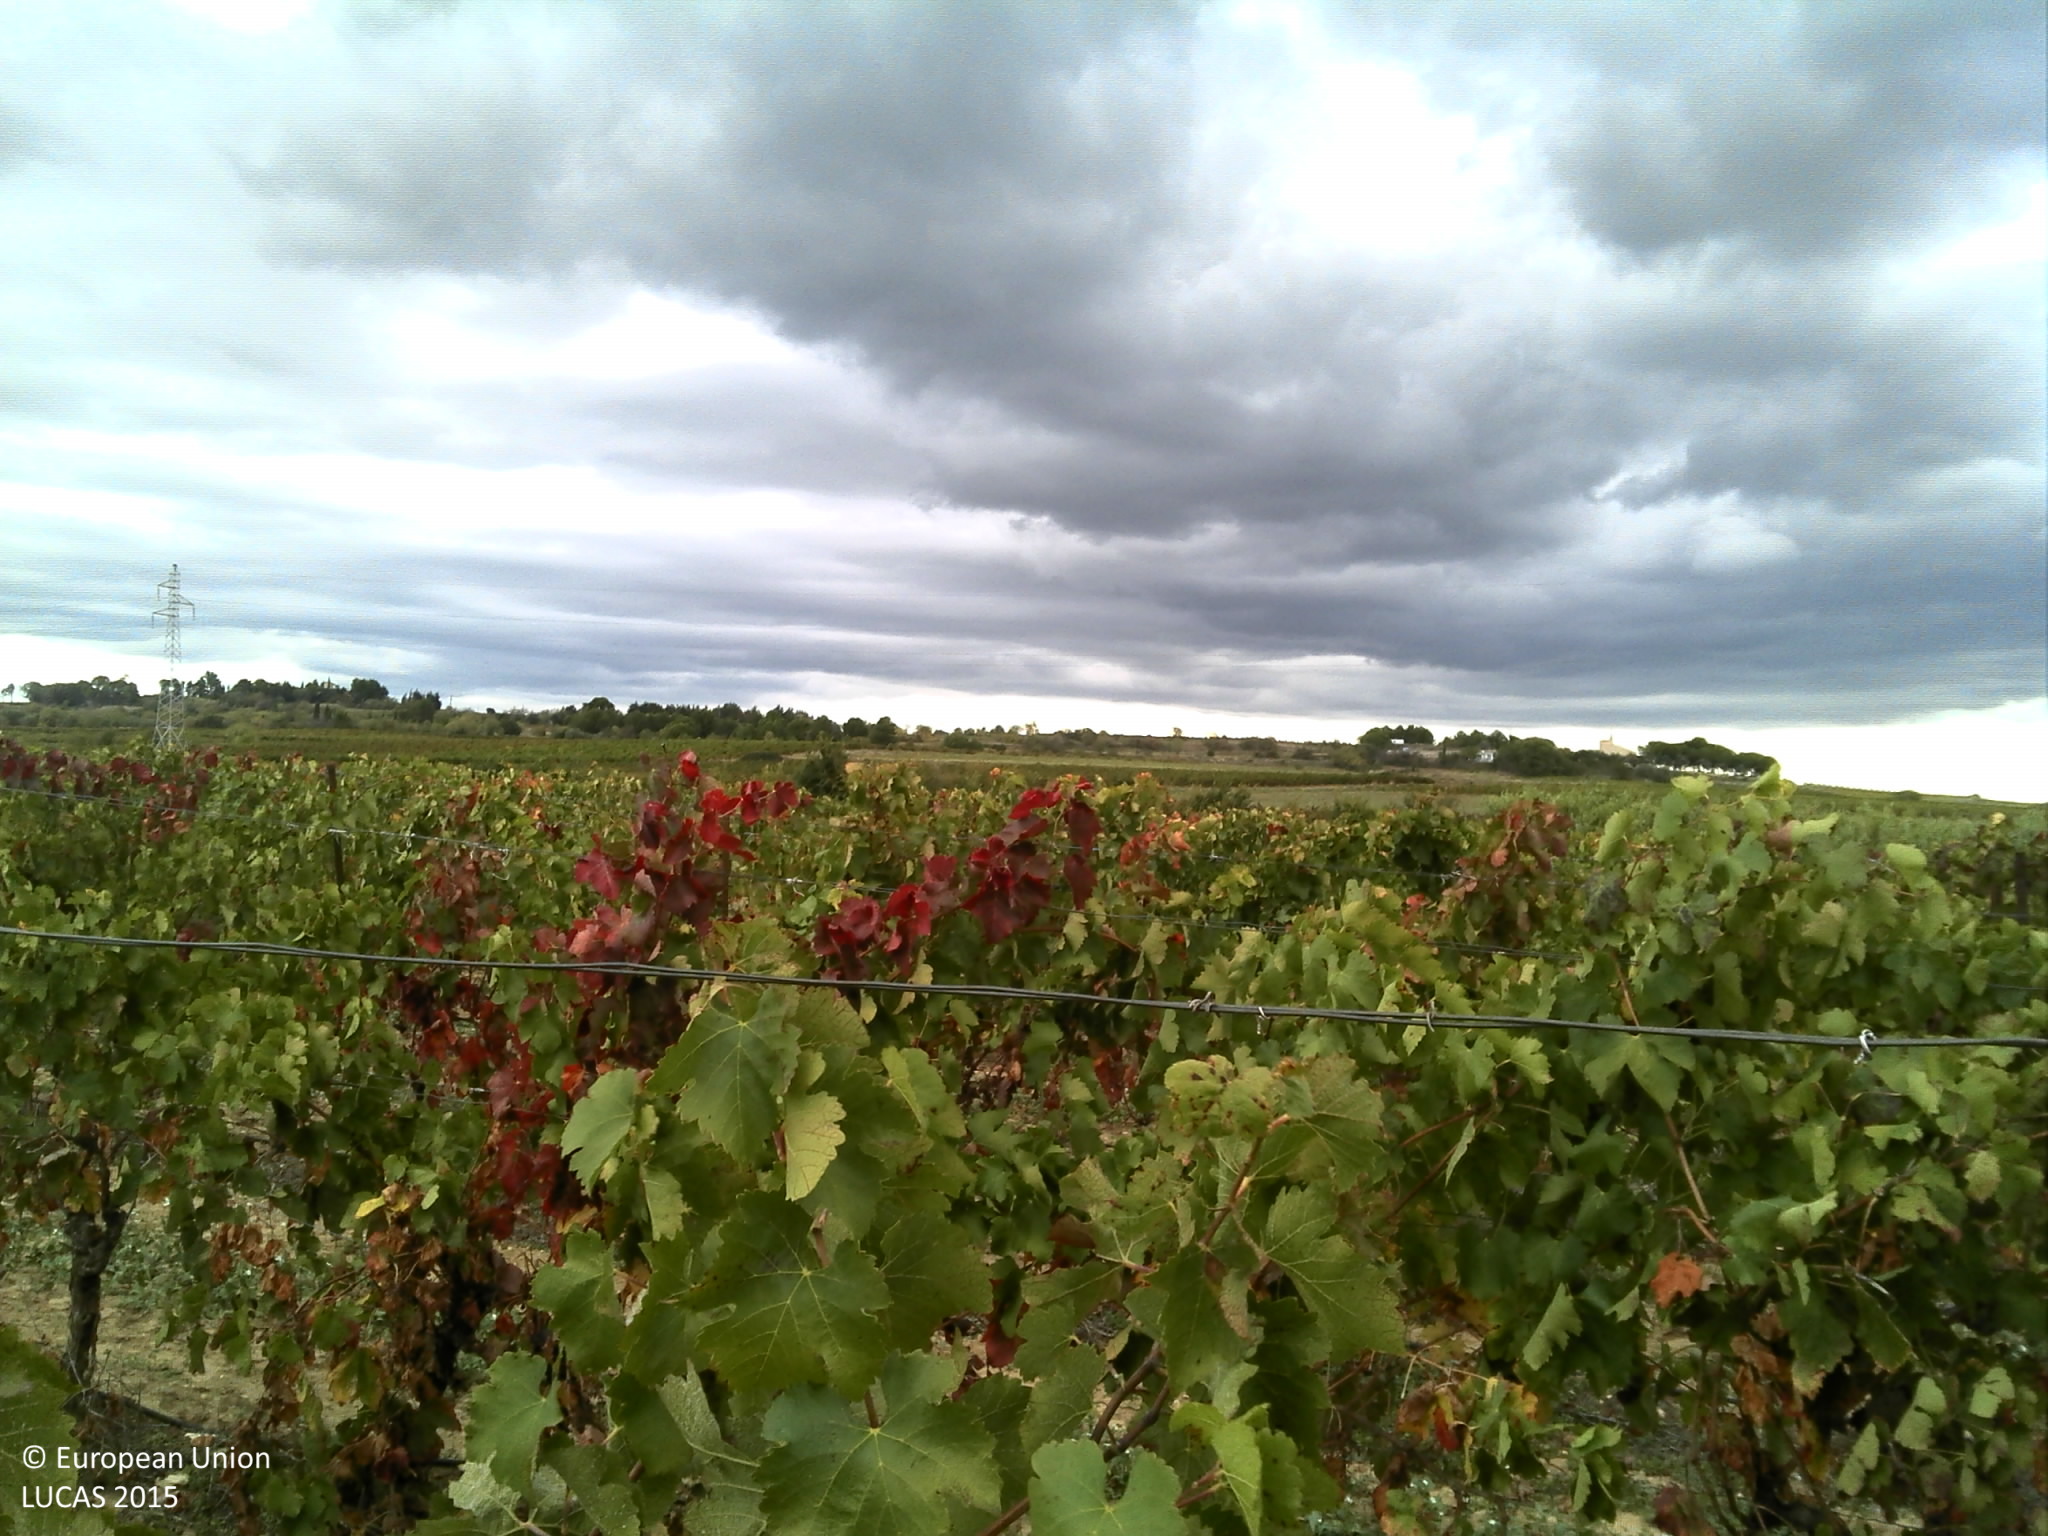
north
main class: Cropland
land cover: Vineyards
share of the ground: 10 - 25 %
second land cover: Spontaneously vegetated surfaces
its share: 50 - 75 %
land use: Agriculture (excluding fallow land and kitchen gardens)
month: October
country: FR
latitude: 43.3629
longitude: 3.1360
